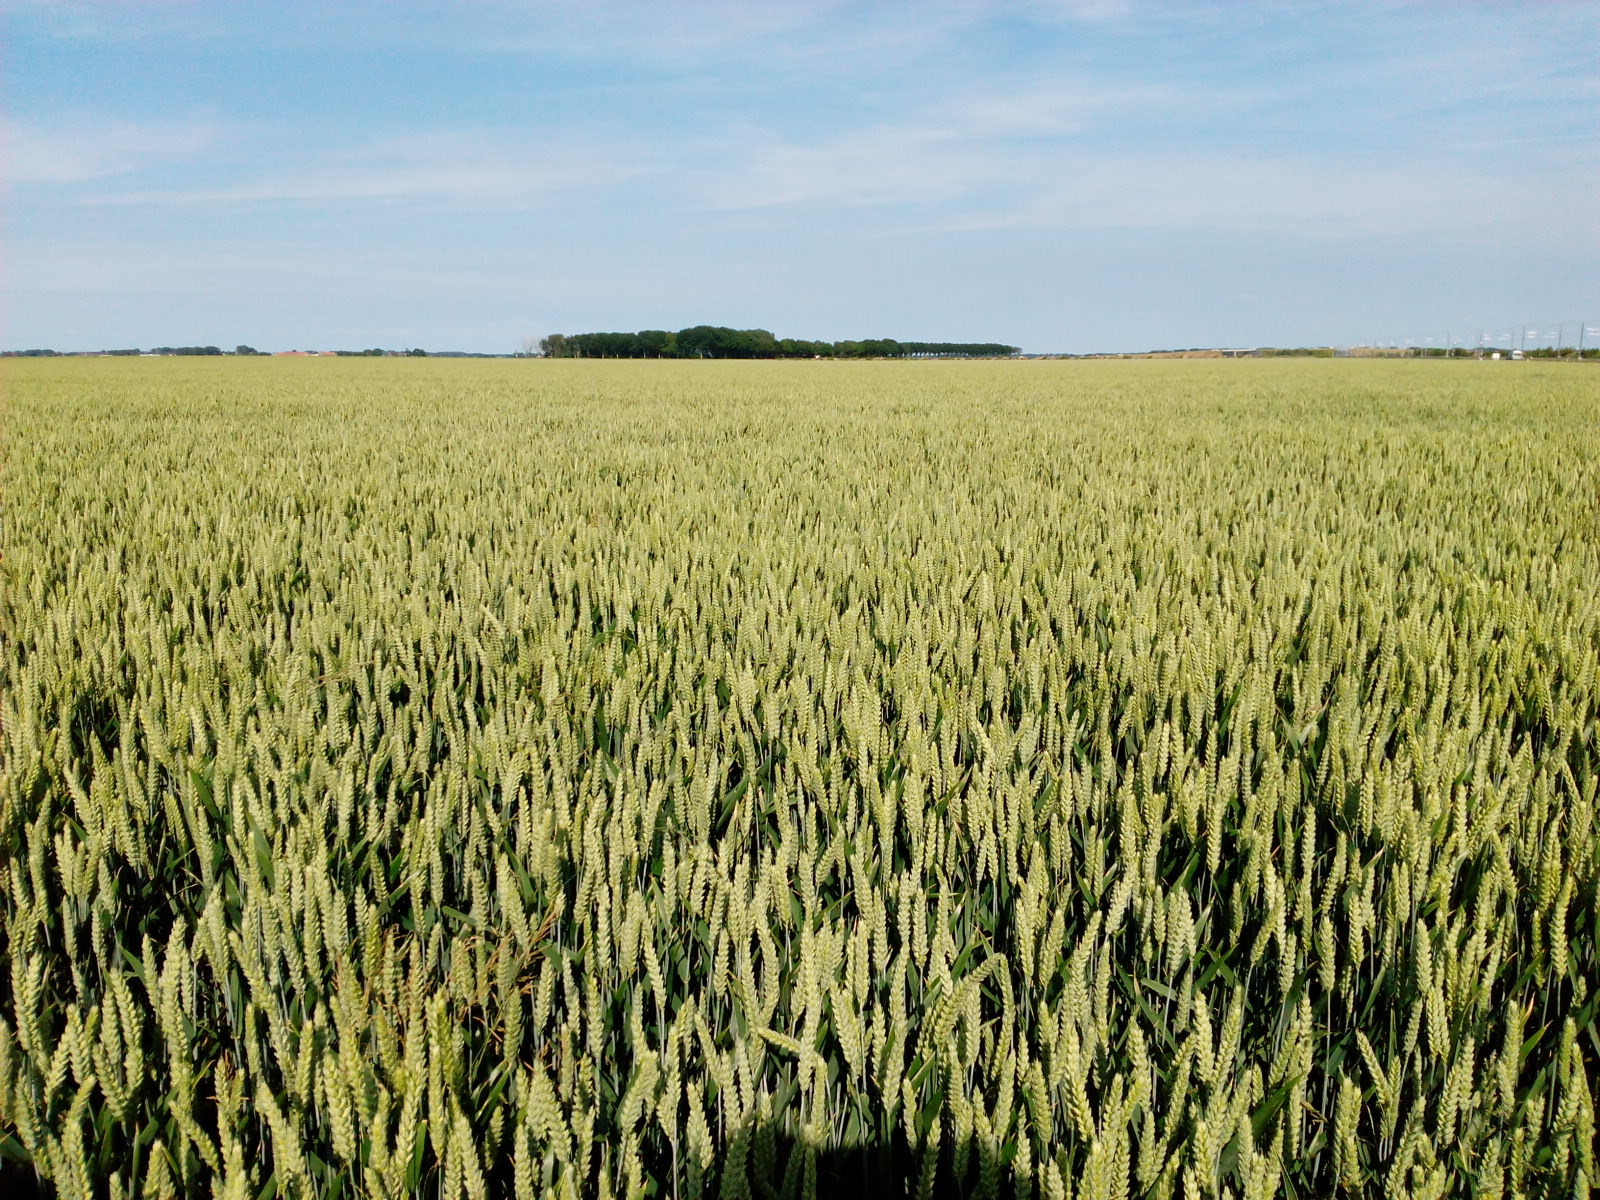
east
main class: Cropland
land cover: Common wheat
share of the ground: > 75 %
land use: Agriculture (excluding fallow land and kitchen gardens)
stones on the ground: < 10 %
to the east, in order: Common wheat
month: June
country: NL
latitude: 52.5498
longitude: 5.6482
